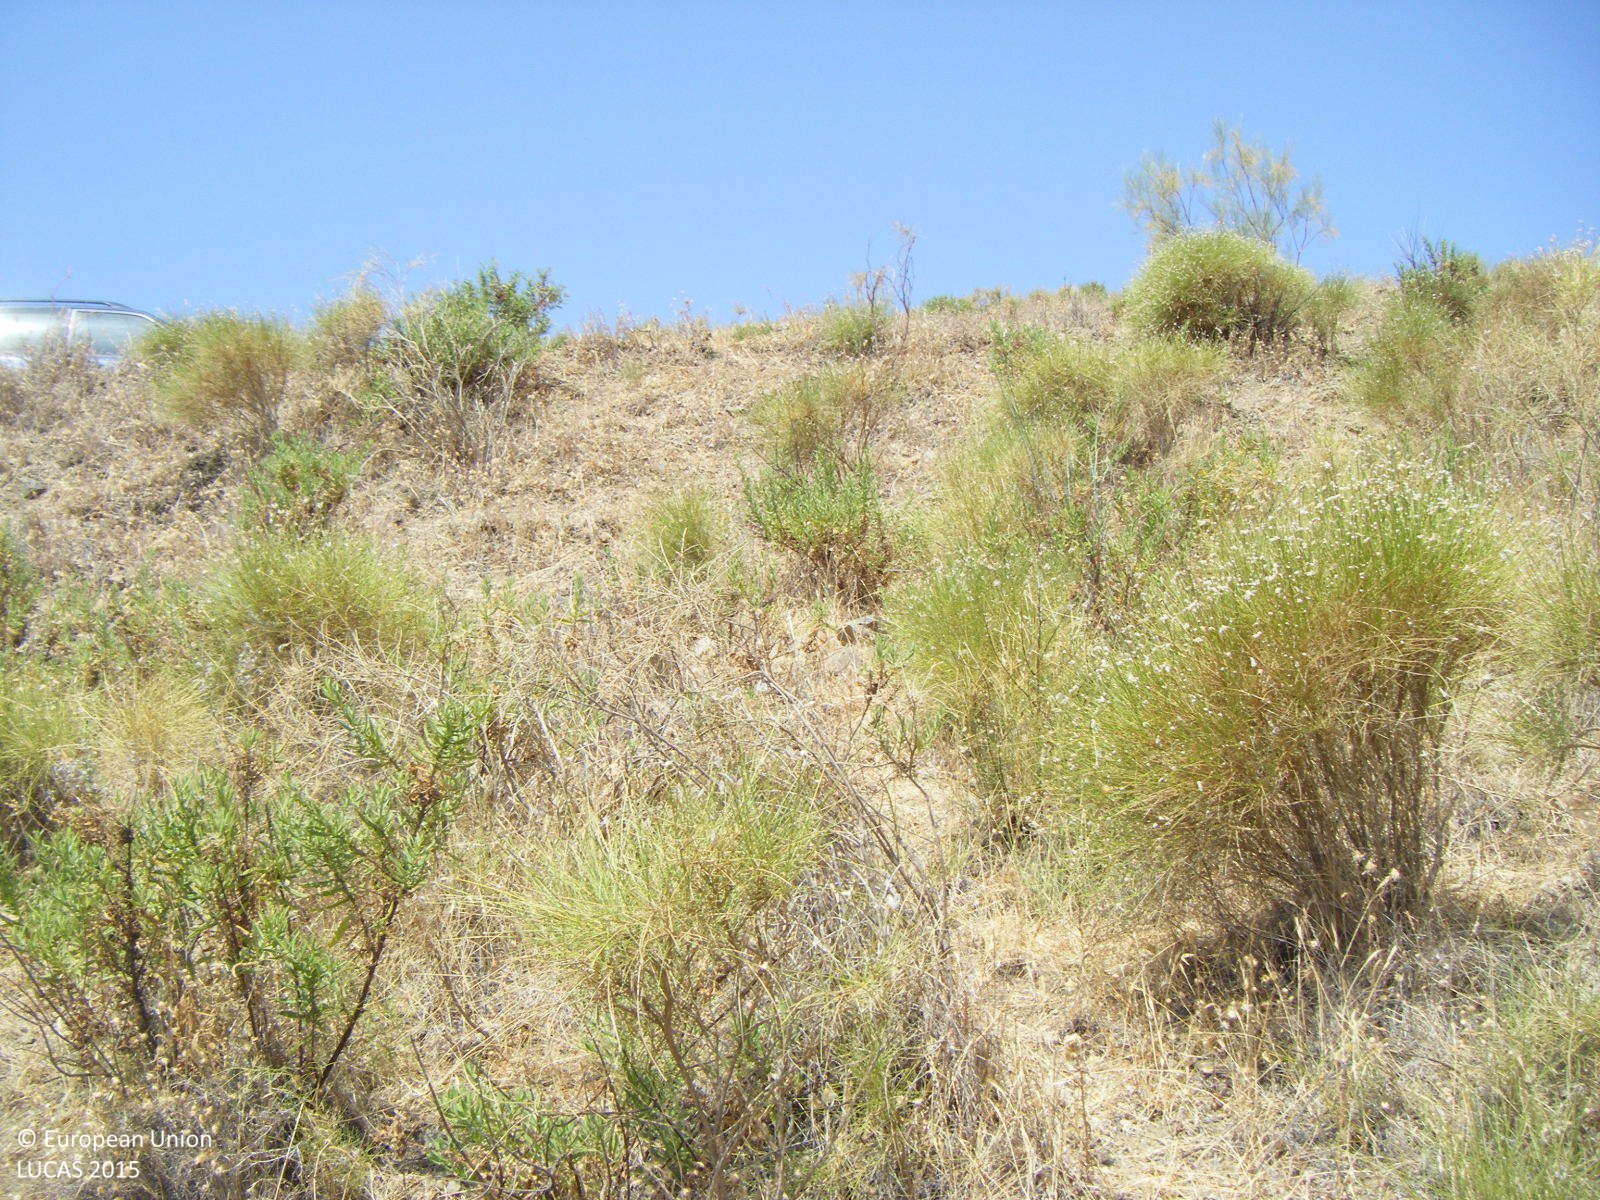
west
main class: Shrubland
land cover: Shrubland without tree cover
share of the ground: 50 - 75 %
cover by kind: shrubs 60 %, herbaceous plants 40 %
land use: Semi-natural and natural areas not in use
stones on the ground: 10 - 25 %
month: July
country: ES
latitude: 36.8619
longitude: -4.0656
